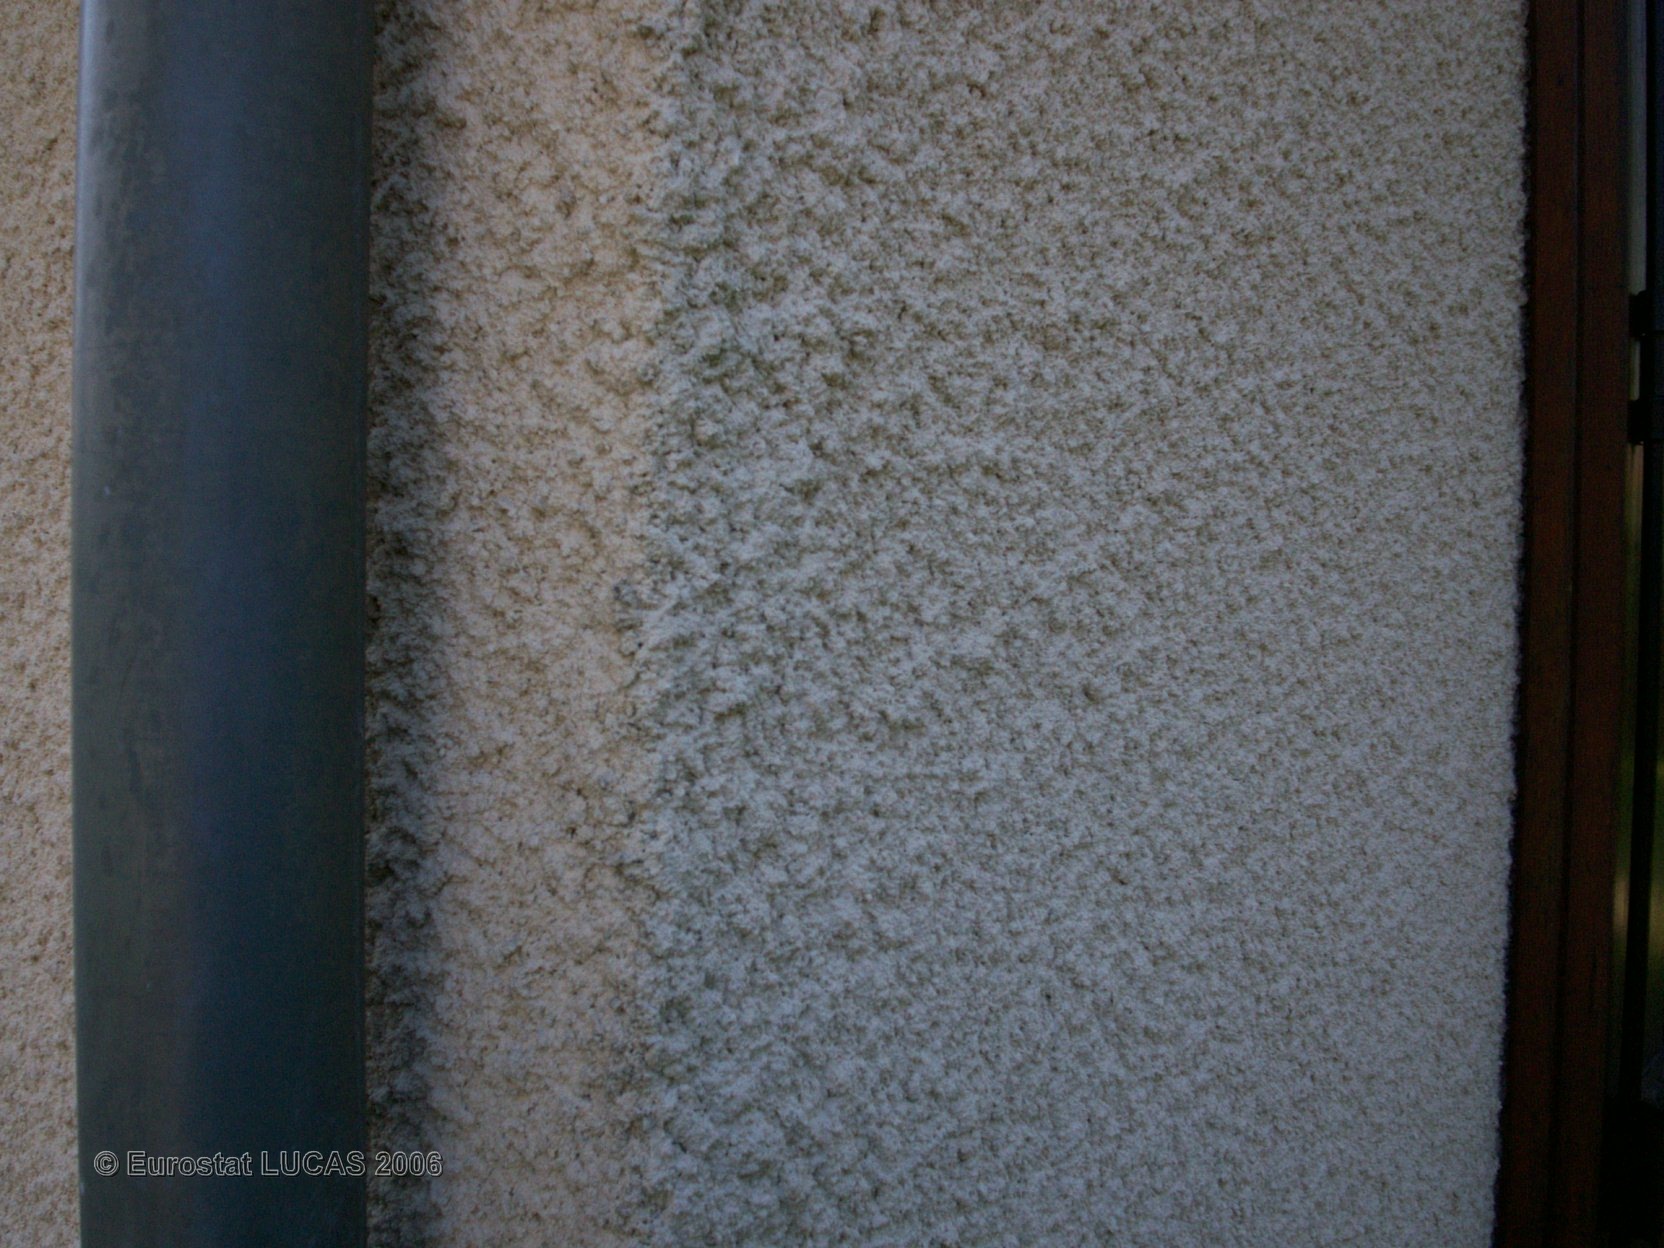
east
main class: Grassland
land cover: Grassland without tree/shrub cover
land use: Residential
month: April
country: FR
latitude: 43.3914
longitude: -0.3900
